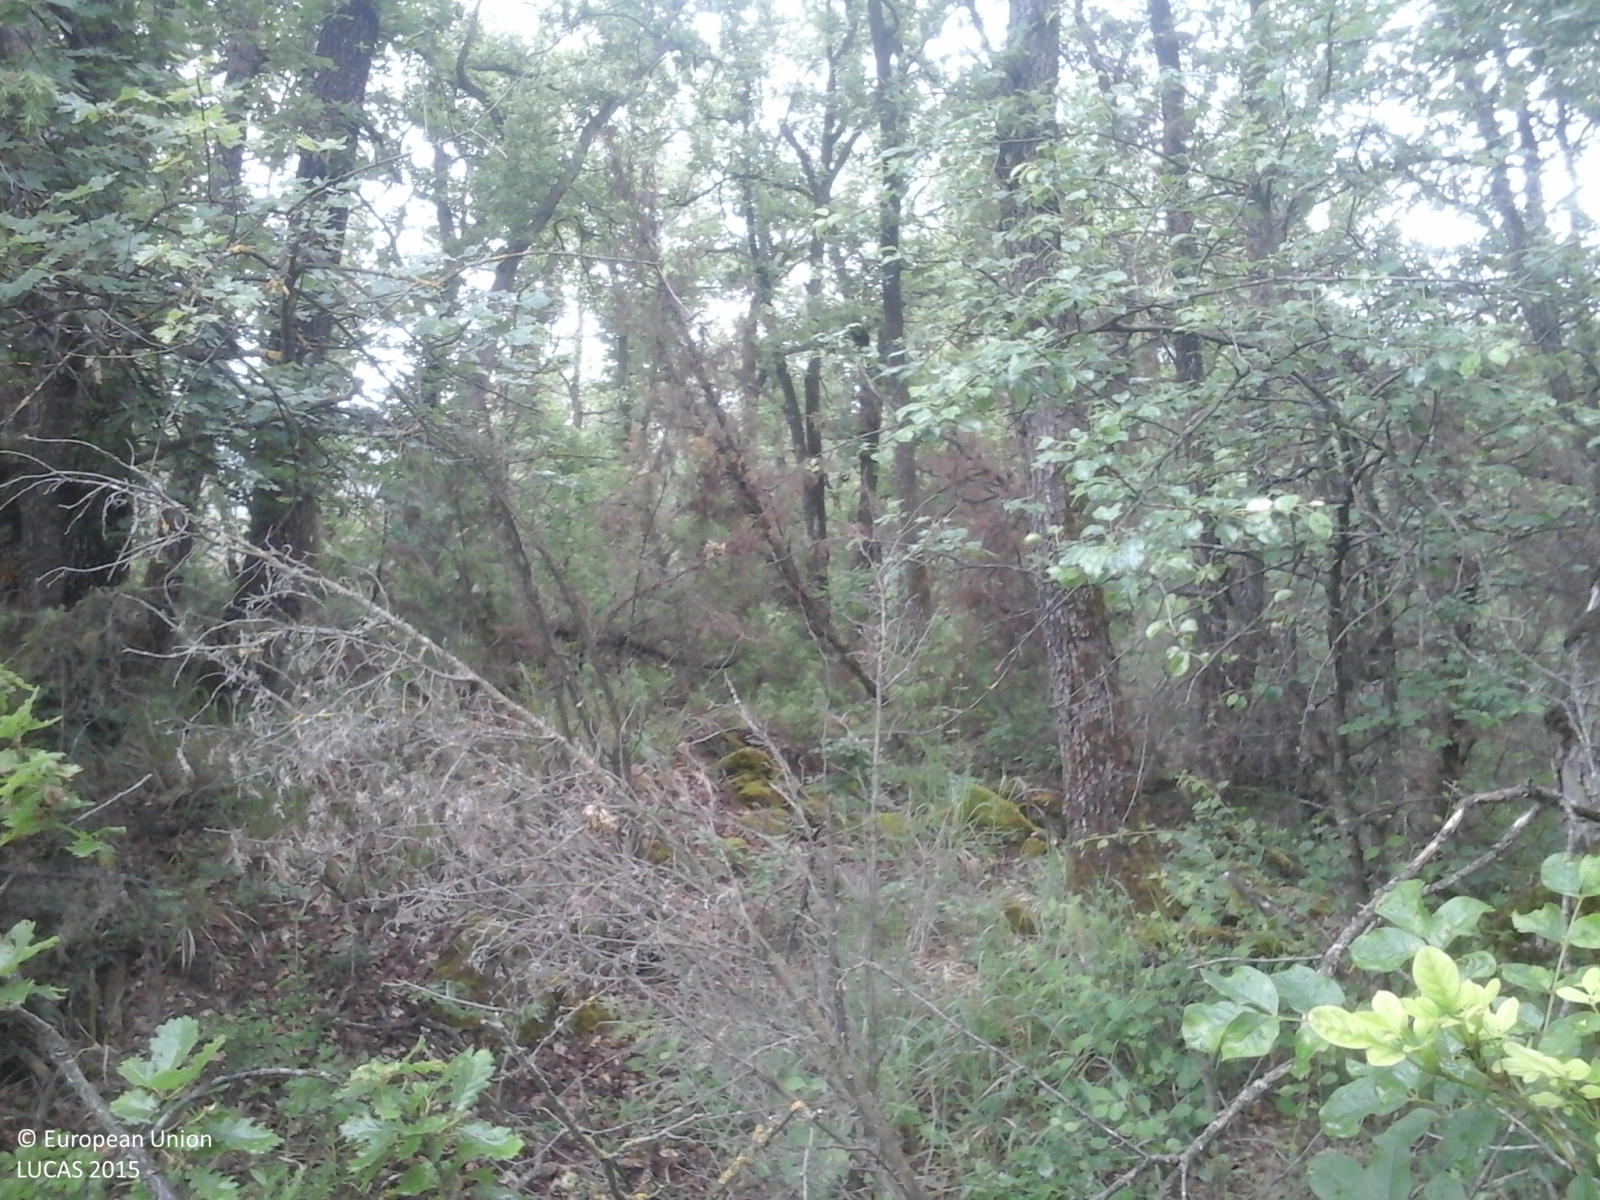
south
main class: Woodland
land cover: Broadleaved woodland
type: thermophilous deciduous forest
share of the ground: > 75 %
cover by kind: broadleaved forest trees 90 %, shrubs 10 %
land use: Forestry
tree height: > 5 m
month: May
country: IT
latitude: 44.2748
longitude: 10.8625
